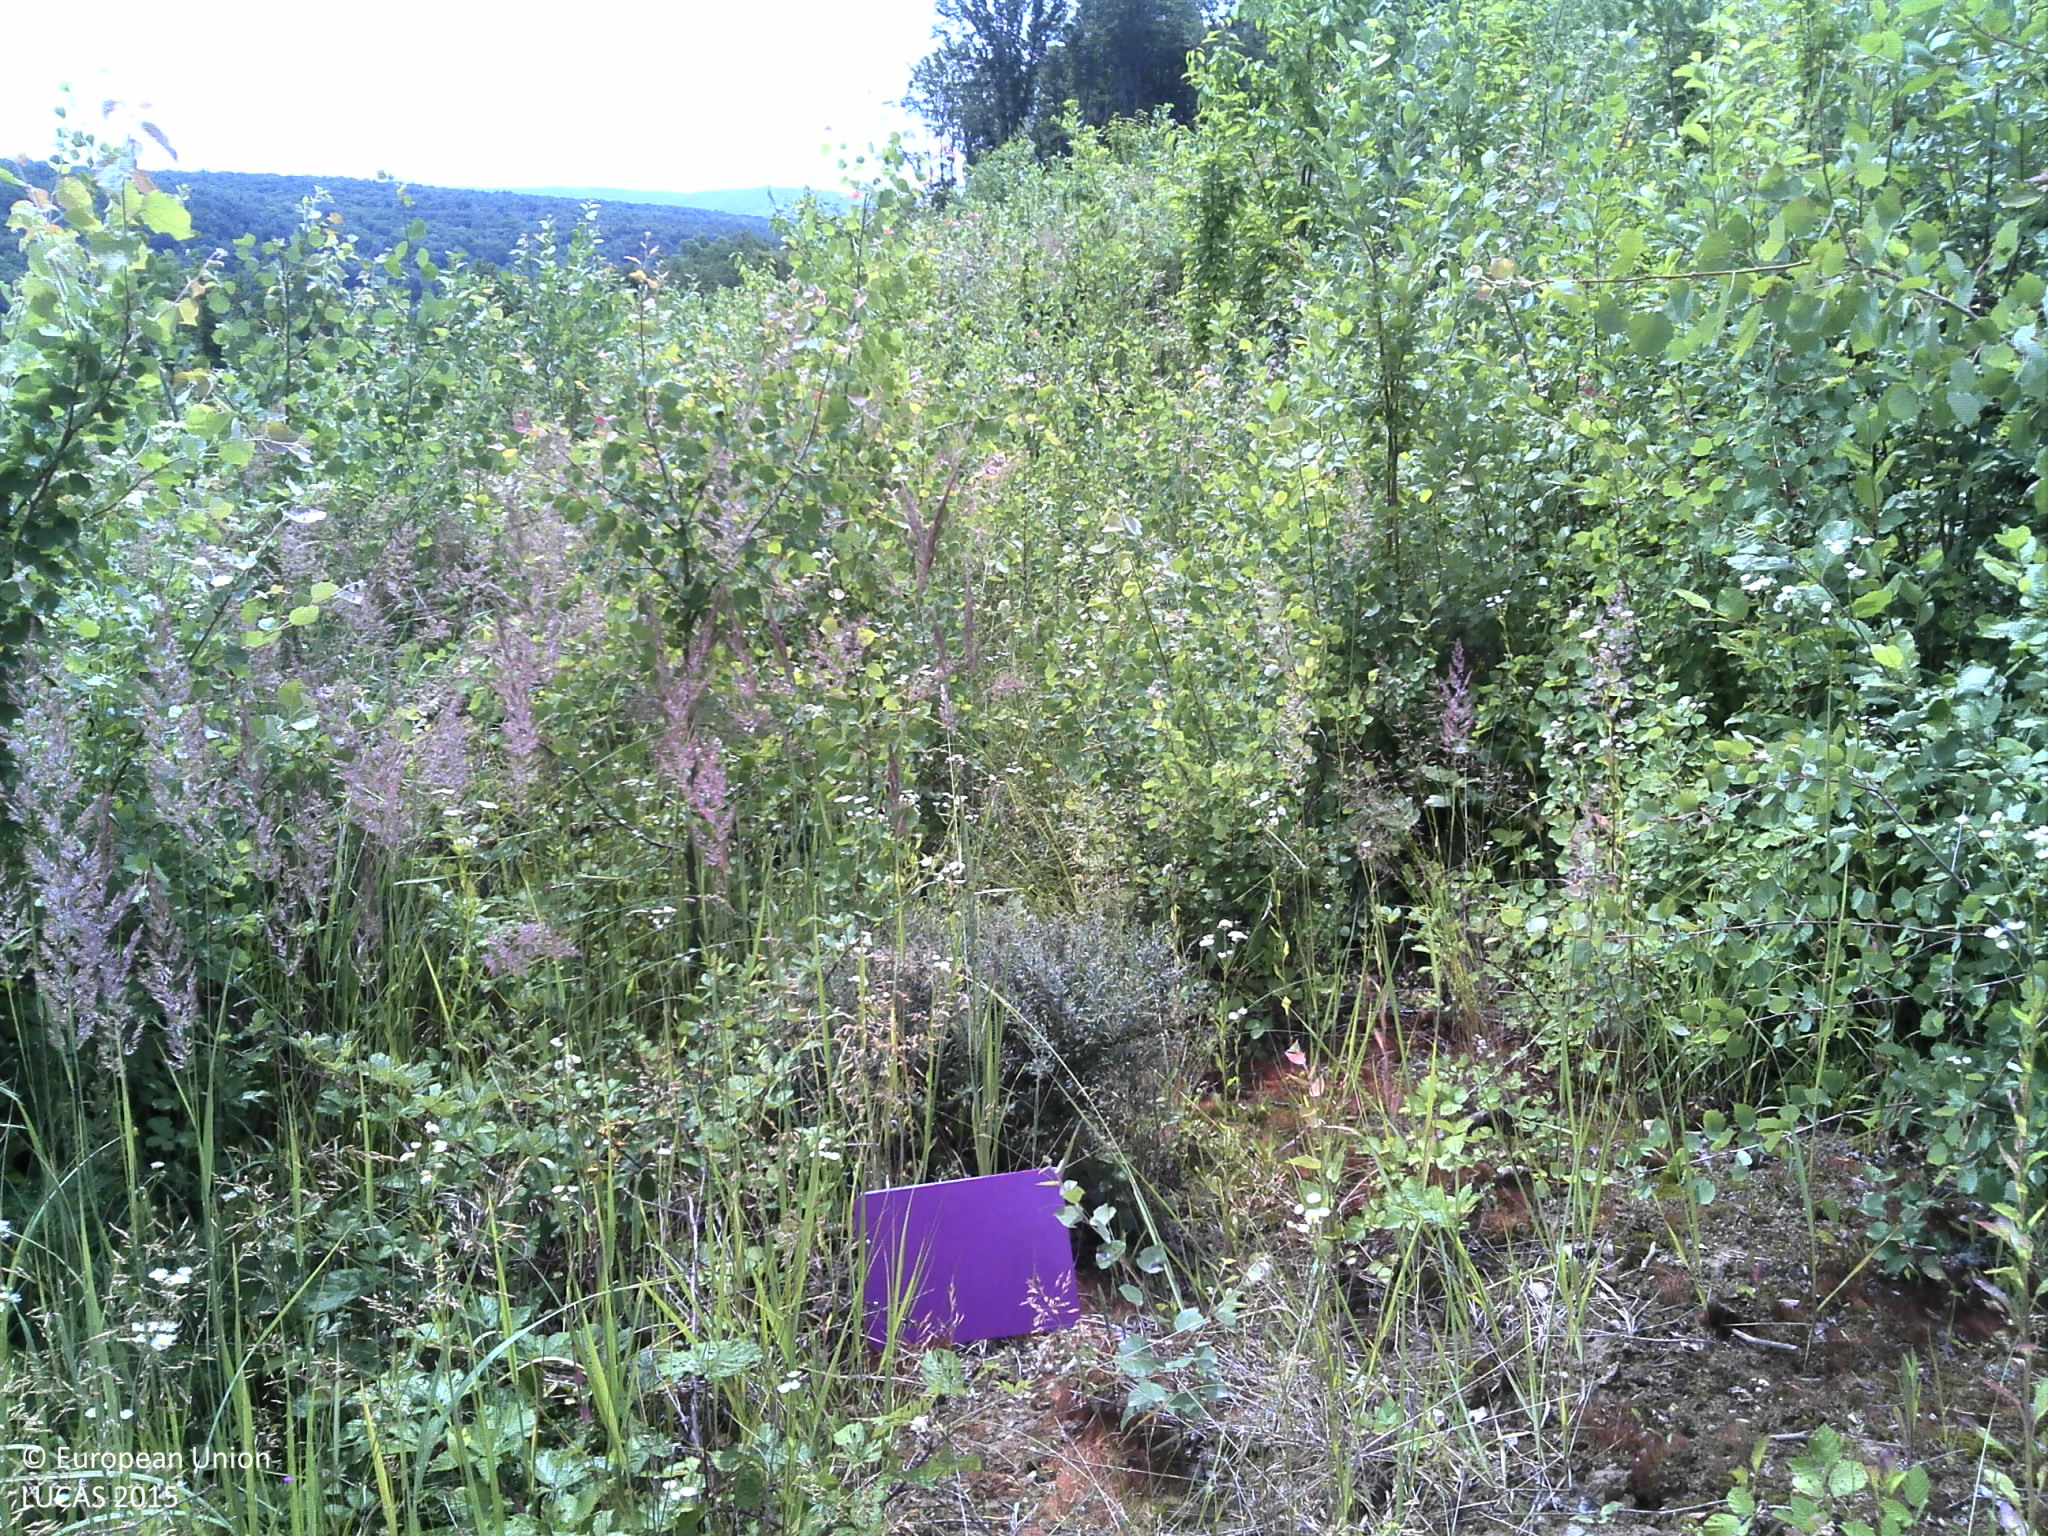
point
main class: Grassland
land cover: Spontaneously vegetated surfaces
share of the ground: > 75 %
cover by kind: herbaceous plants 90 %, shrubs 5 %, lichens and mosses 5 %
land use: Forestry
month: June
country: HR
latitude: 45.3358
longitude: 17.3889
